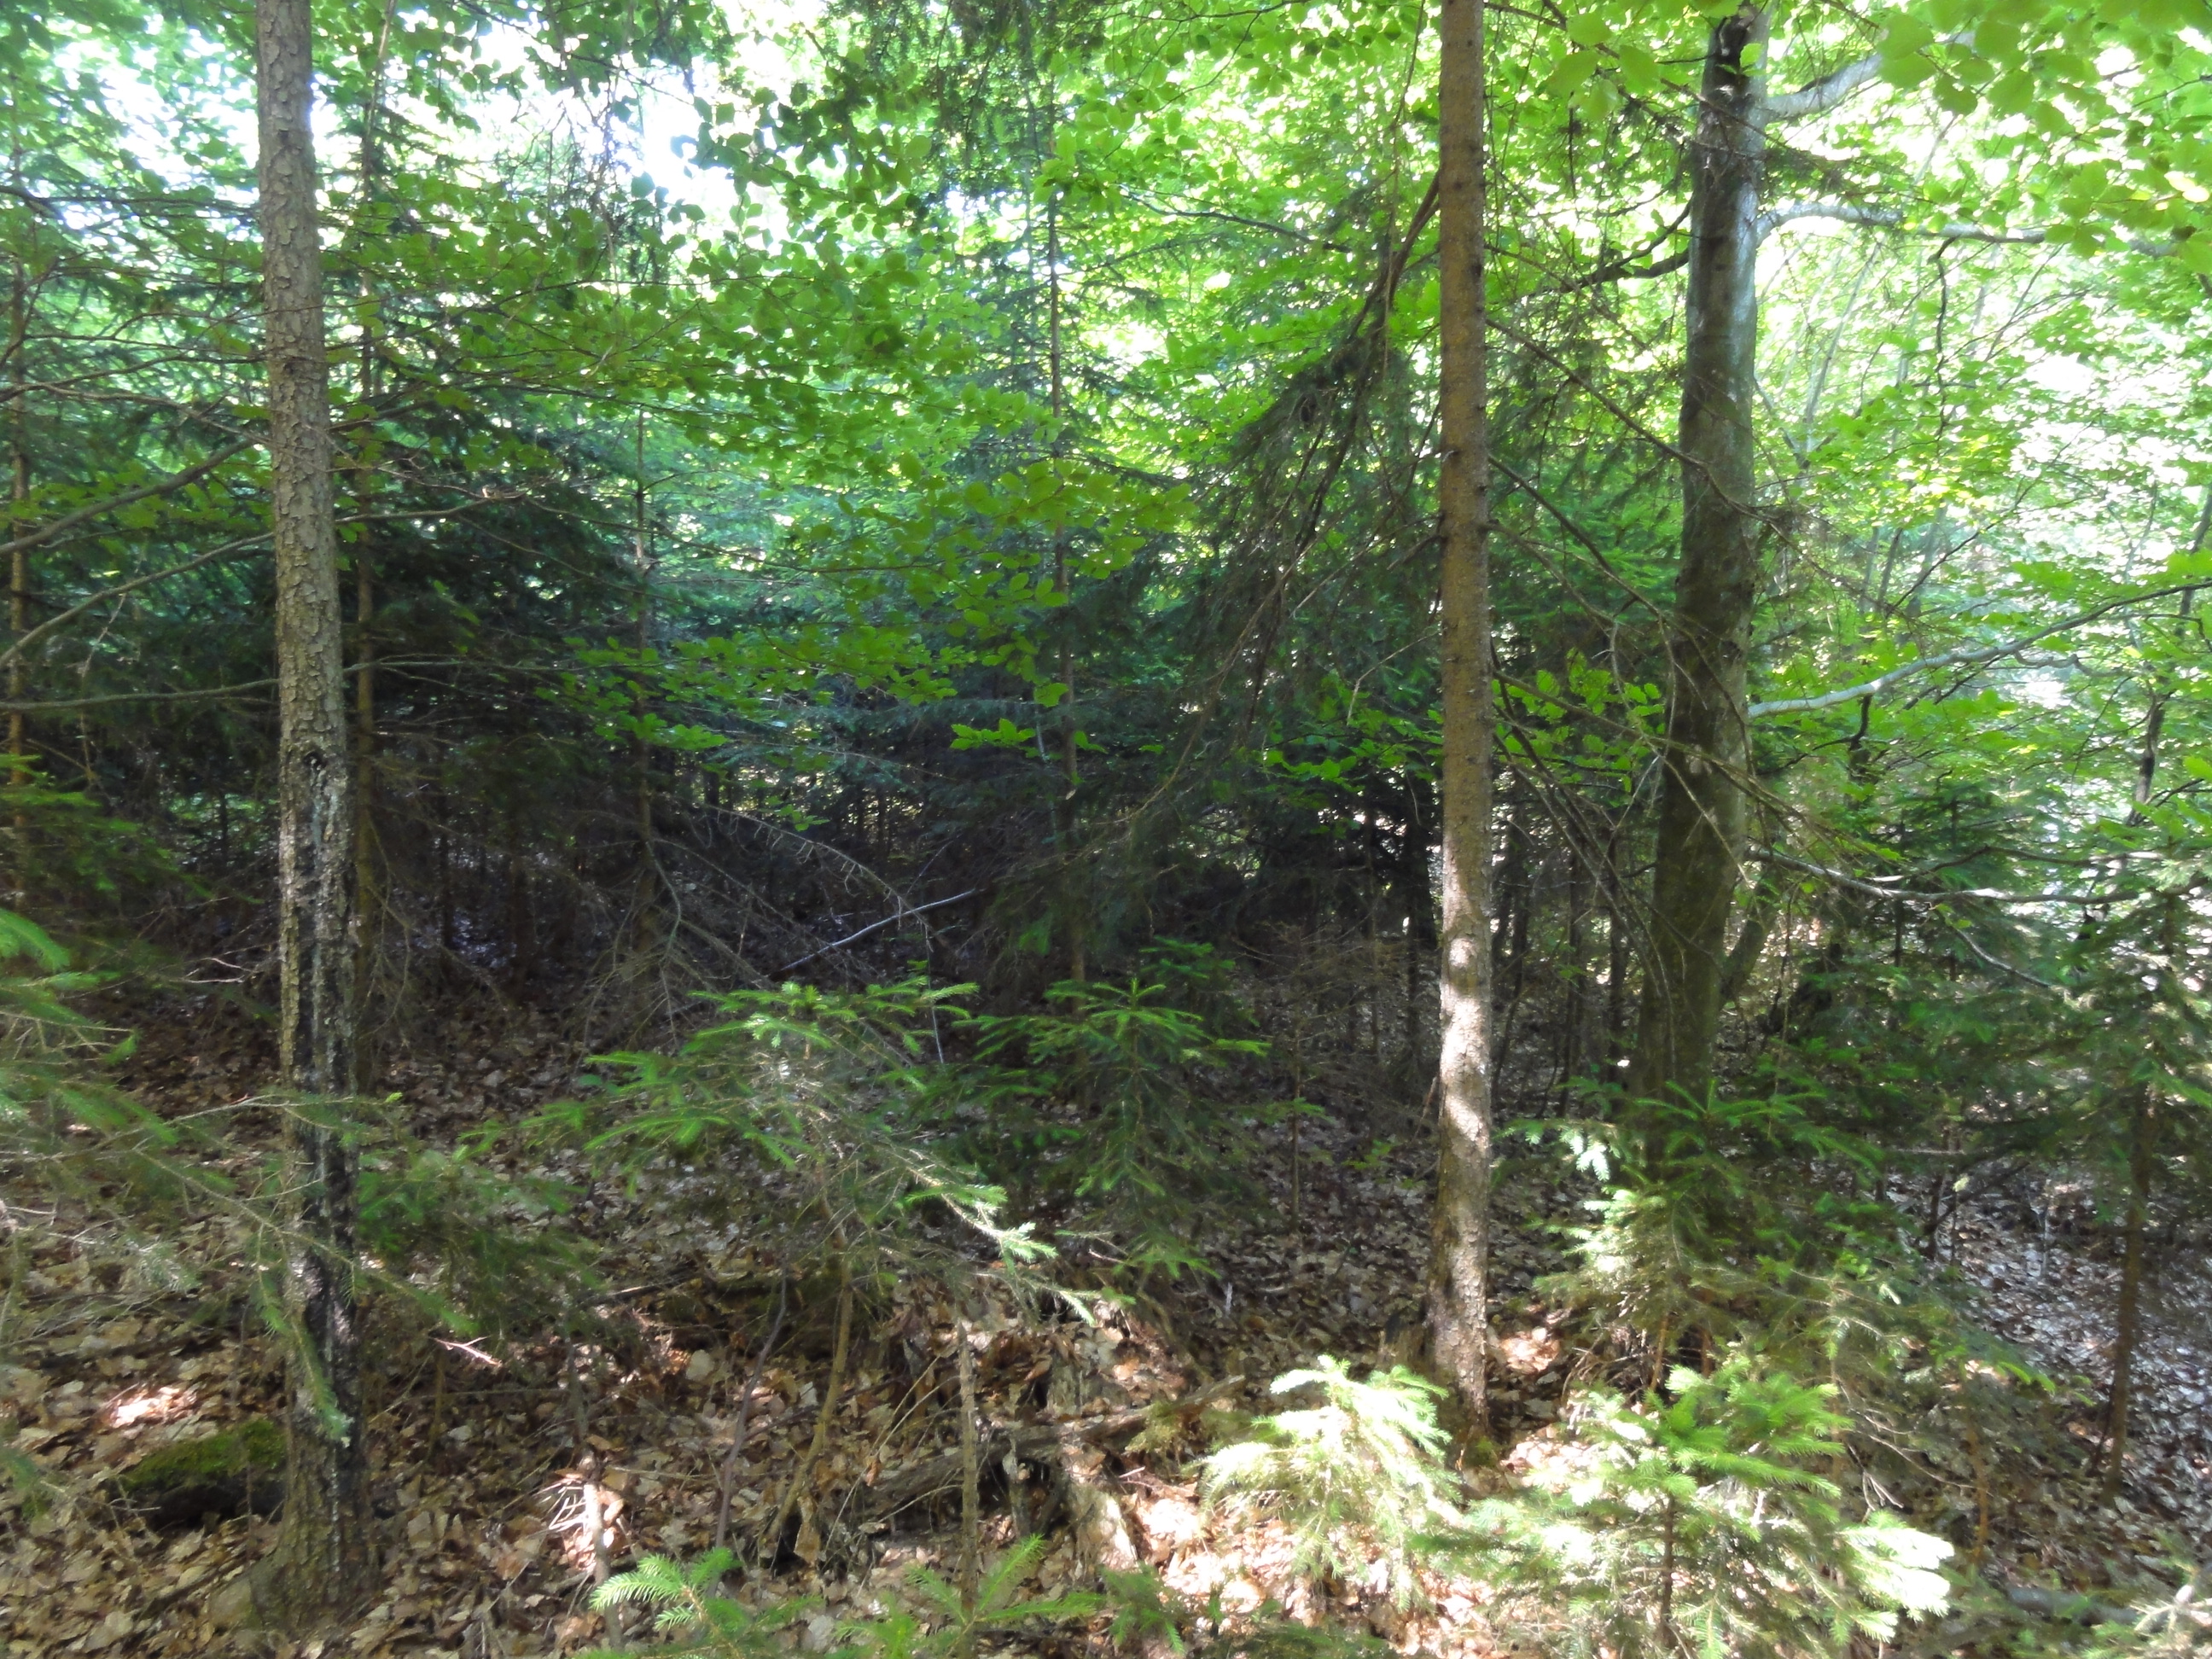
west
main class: Woodland
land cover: Spruce dominated mixed woodland
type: mountainous beech forest
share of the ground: 50 - 75 %
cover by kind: broadleaved forest trees 35 %, coniferous forest trees 30 %, shrubs 20 %, herbaceous plants 5 %, unconsolidated bare surface 5 %
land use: Forestry
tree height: > 5 m
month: June
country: SI
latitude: 46.2071
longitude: 14.8055
